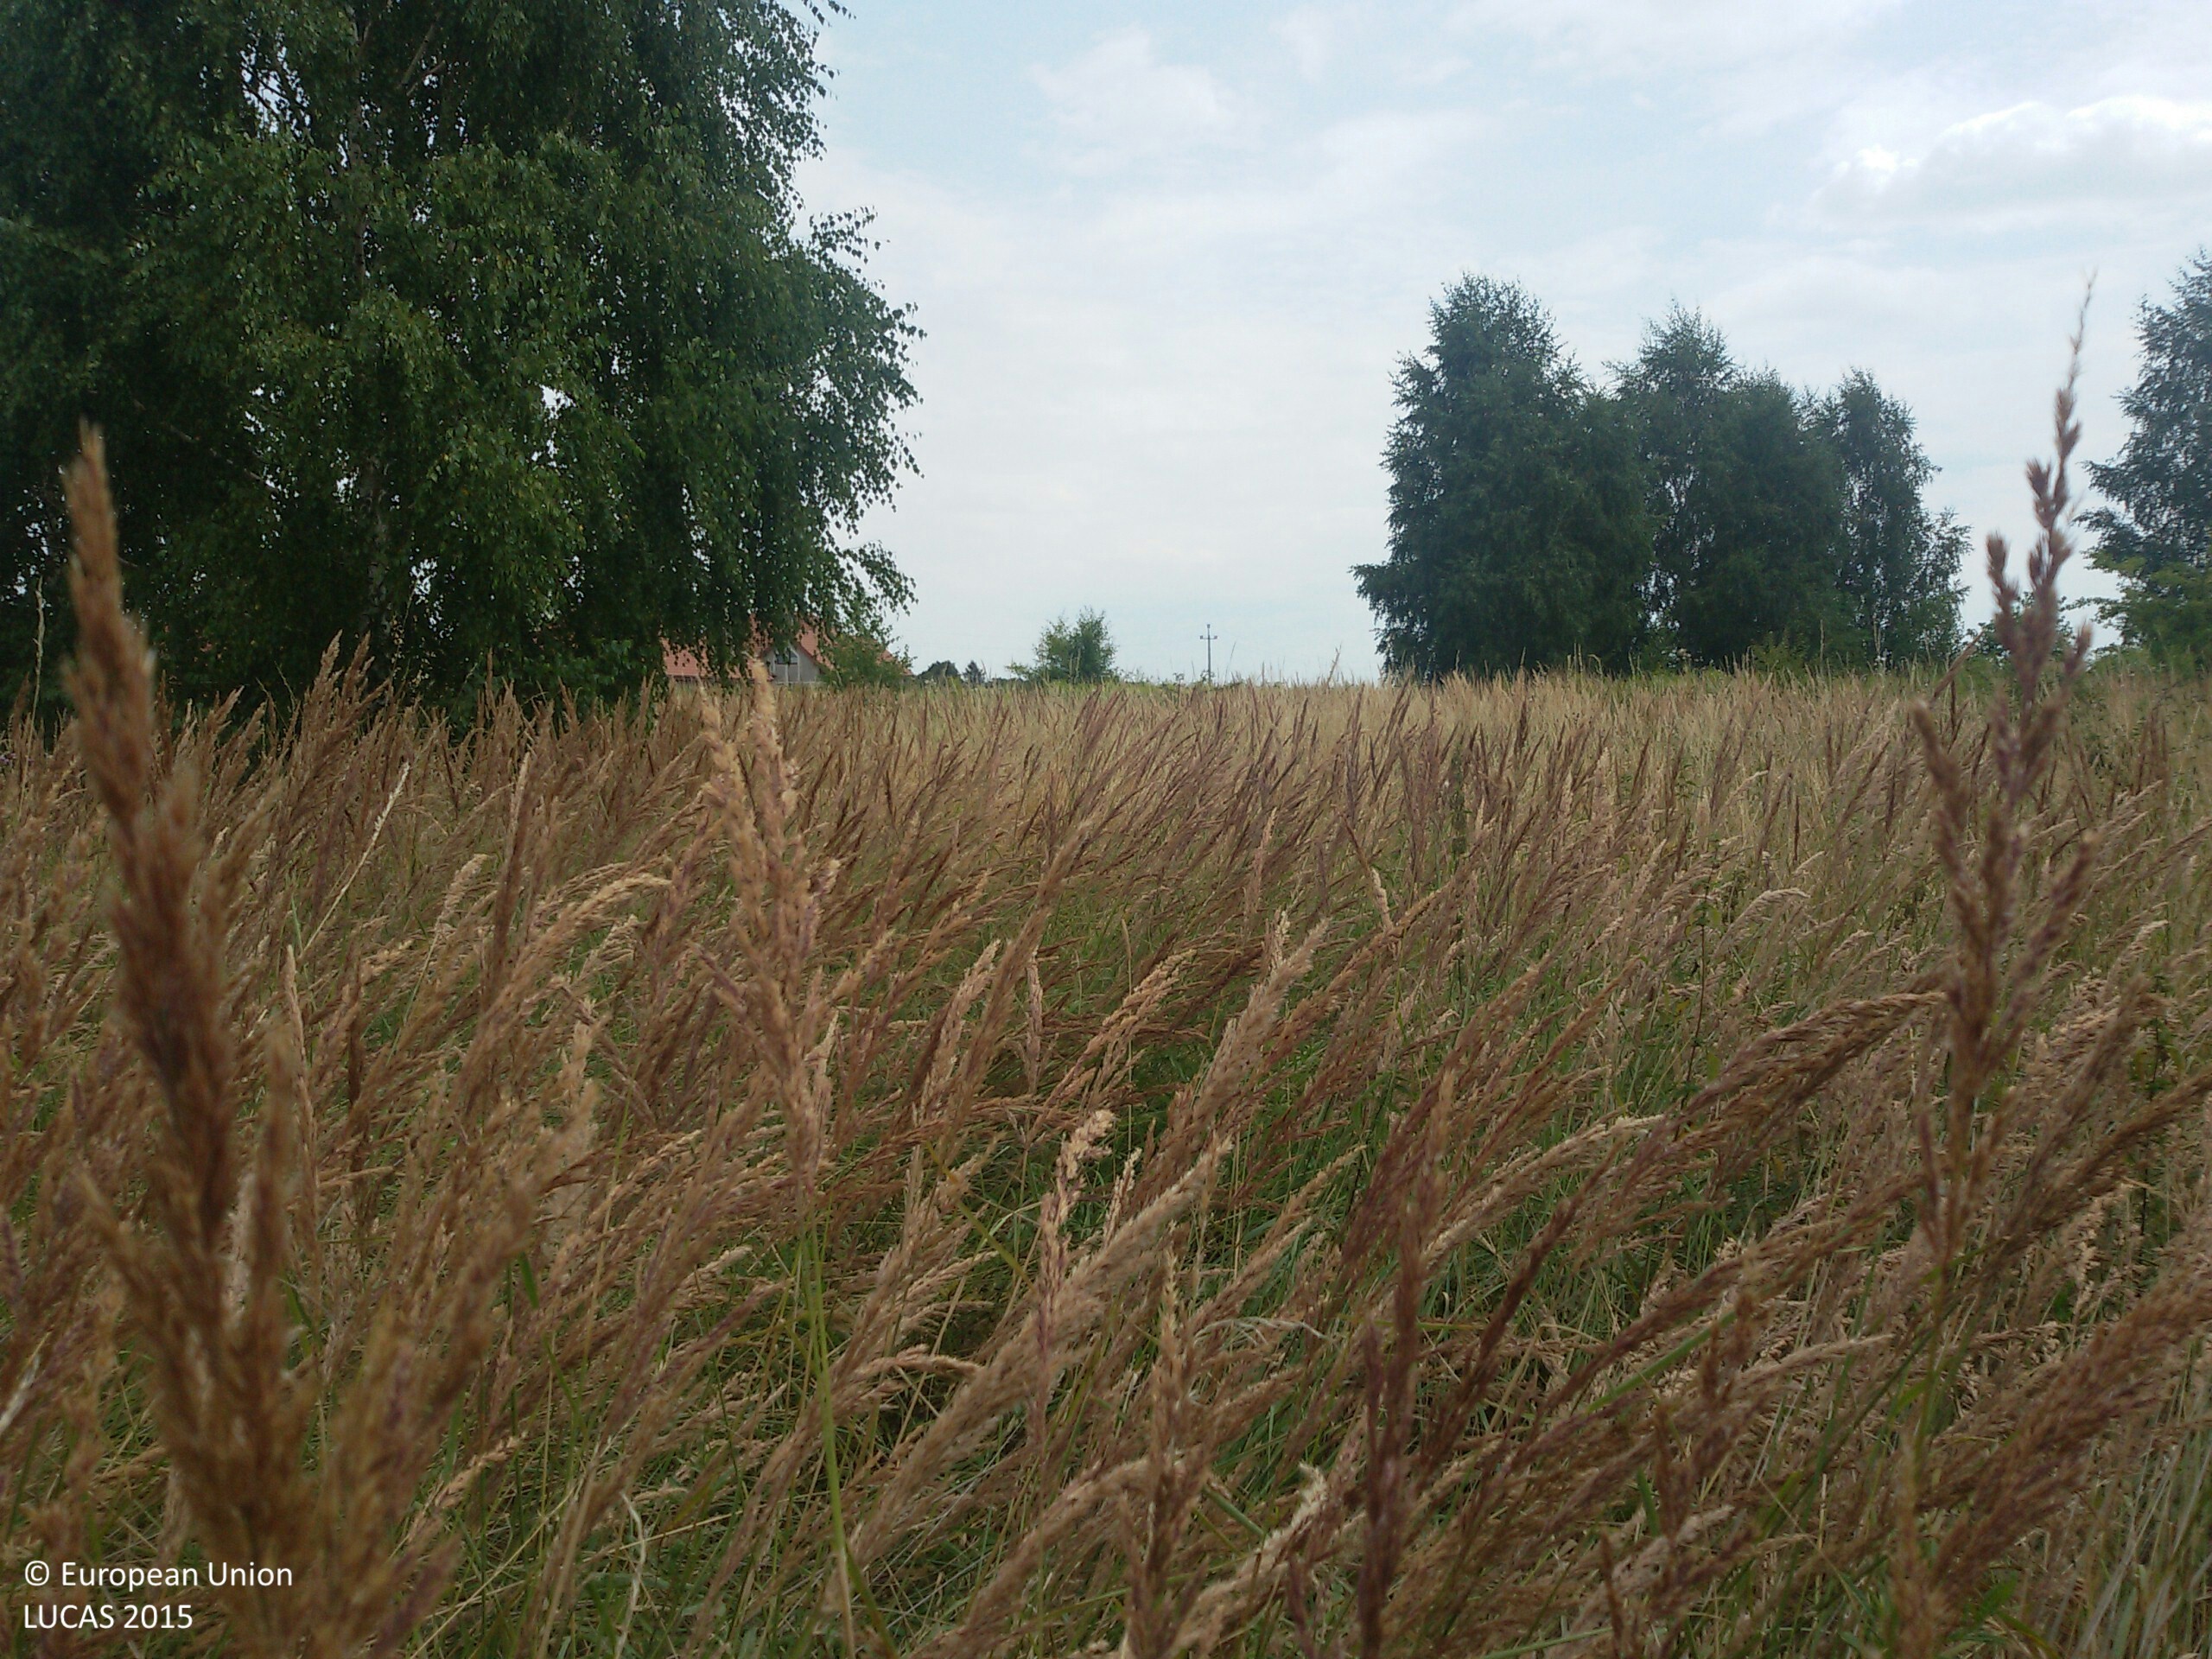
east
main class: Woodland
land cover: Broadleaved woodland
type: mesophytic deciduous forest
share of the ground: 10 - 25 %
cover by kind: herbaceous plants 85 %, broadleaved forest trees 15 %
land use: Abandoned areas
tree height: > 5 m
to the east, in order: Broadleaved woodland; Grassland without tree/shrub cover; Artificial constructions in urban areas; Other bare soil; Artificial constructions in urban areas
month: August
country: PL
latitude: 51.3231
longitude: 22.7414
